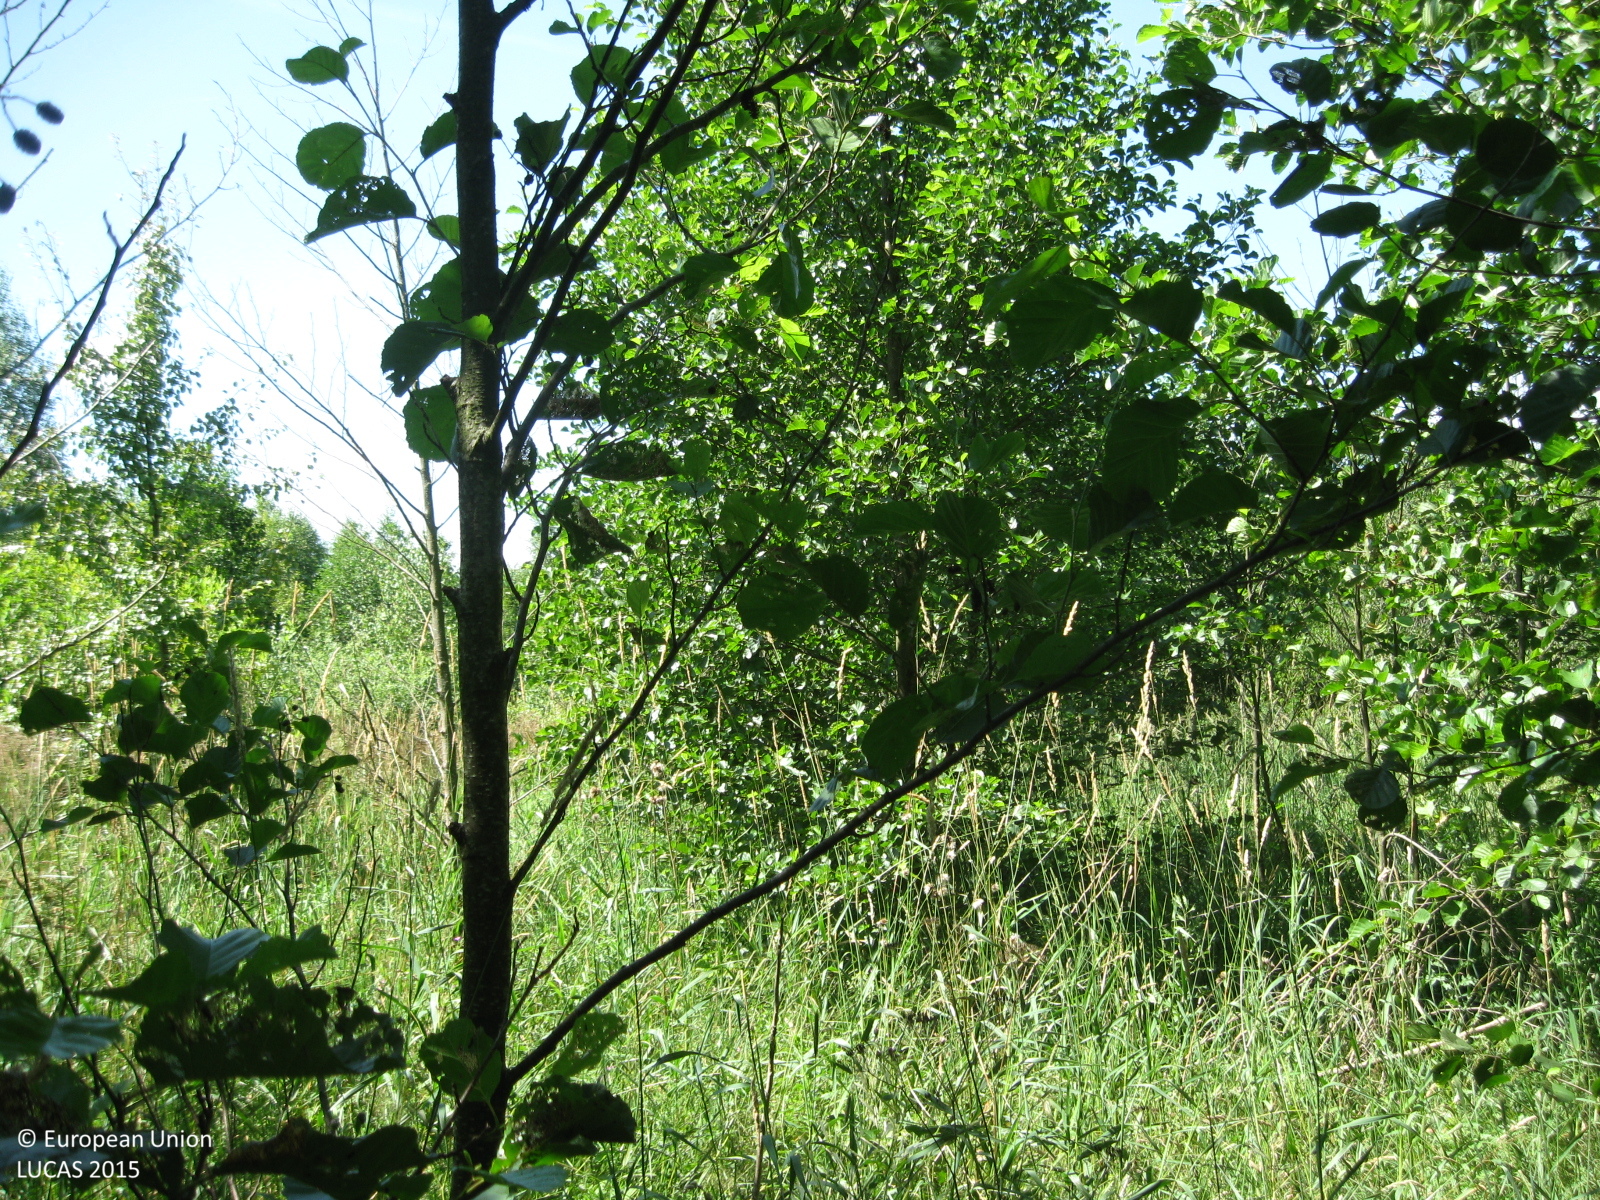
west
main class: Woodland
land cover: Broadleaved woodland
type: non-riverine alder, birch or aspen forest
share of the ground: > 75 %
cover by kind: broadleaved forest trees 75 %, herbaceous plants 25 %
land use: Forestry
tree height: > 5 m
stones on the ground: < 10 %
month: July
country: LT
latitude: 55.1394
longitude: 24.6470
